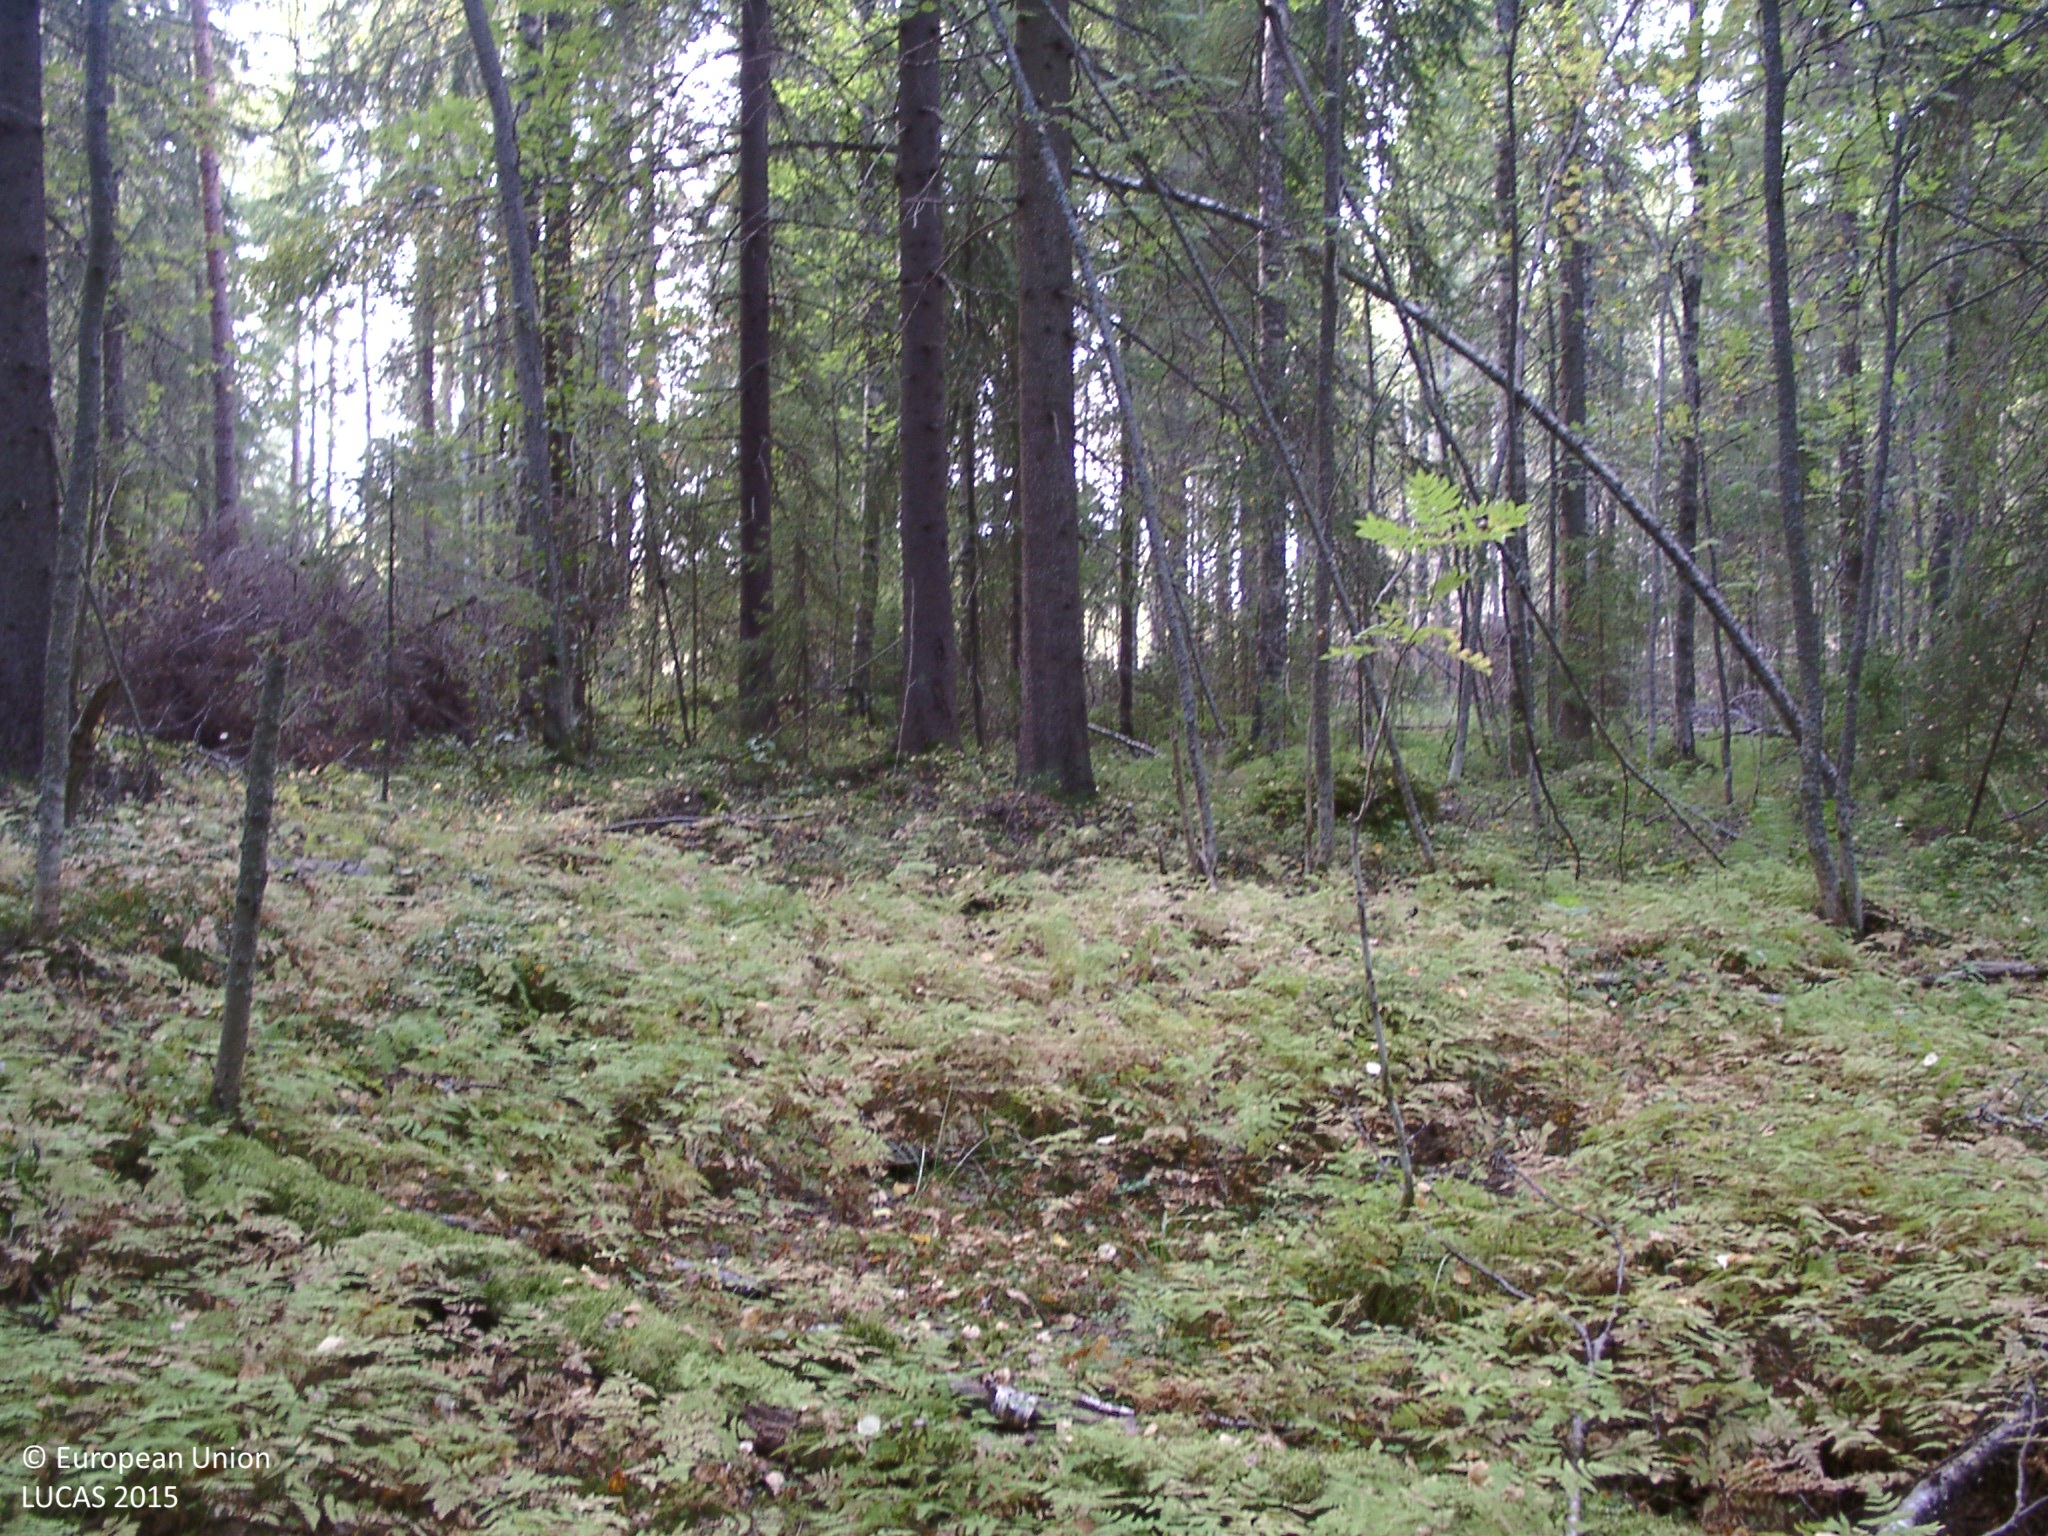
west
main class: Woodland
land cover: Spruce dominated mixed woodland
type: boreal forest
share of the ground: > 75 %
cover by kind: coniferous forest trees 45 %, broadleaved forest trees 40 %, herbaceous plants 10 %, lichens and mosses 5 %
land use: Forestry
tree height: > 5 m
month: September
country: FI
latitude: 62.6051
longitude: 25.7604
